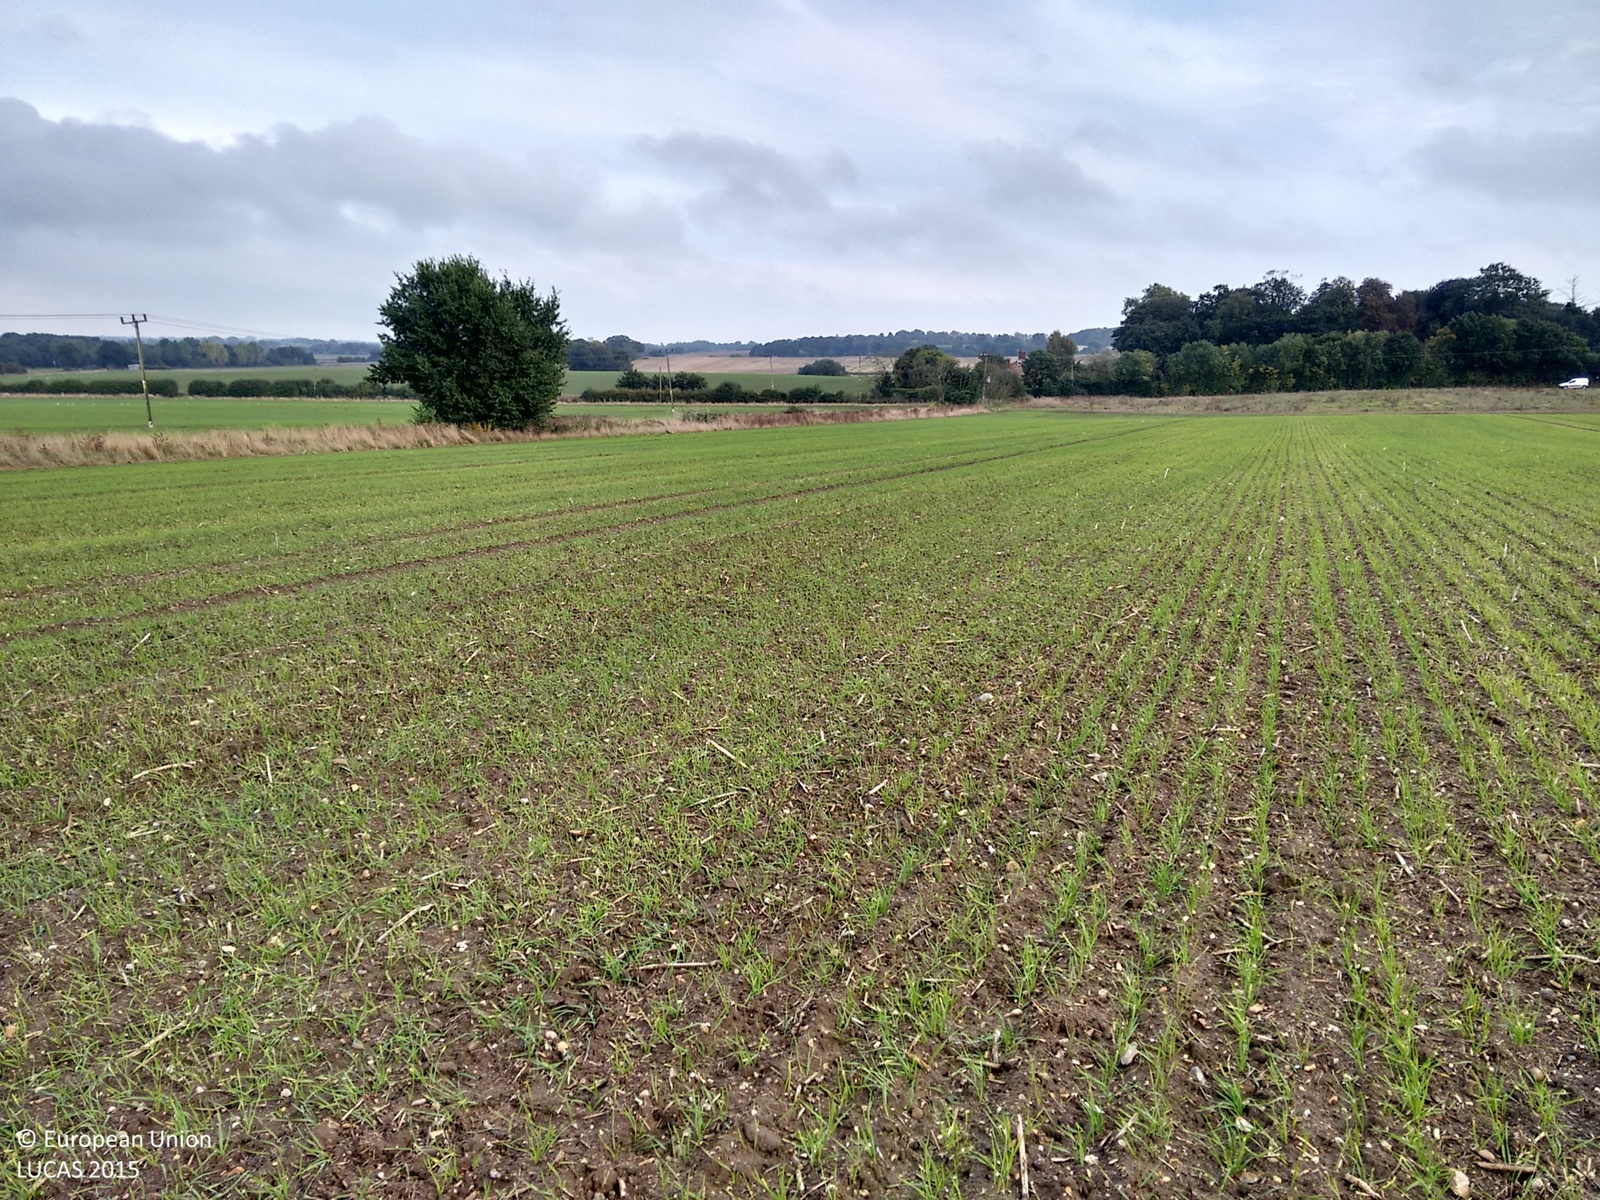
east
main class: Cropland
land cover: Common wheat
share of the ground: 10 - 25 %
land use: Agriculture (excluding fallow land and kitchen gardens)
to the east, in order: Common wheat; Grassland without tree/shrub cover; Common wheat; Electric lines; Common wheat; Grass margins
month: October
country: GB
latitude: 52.4533
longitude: 1.5198
